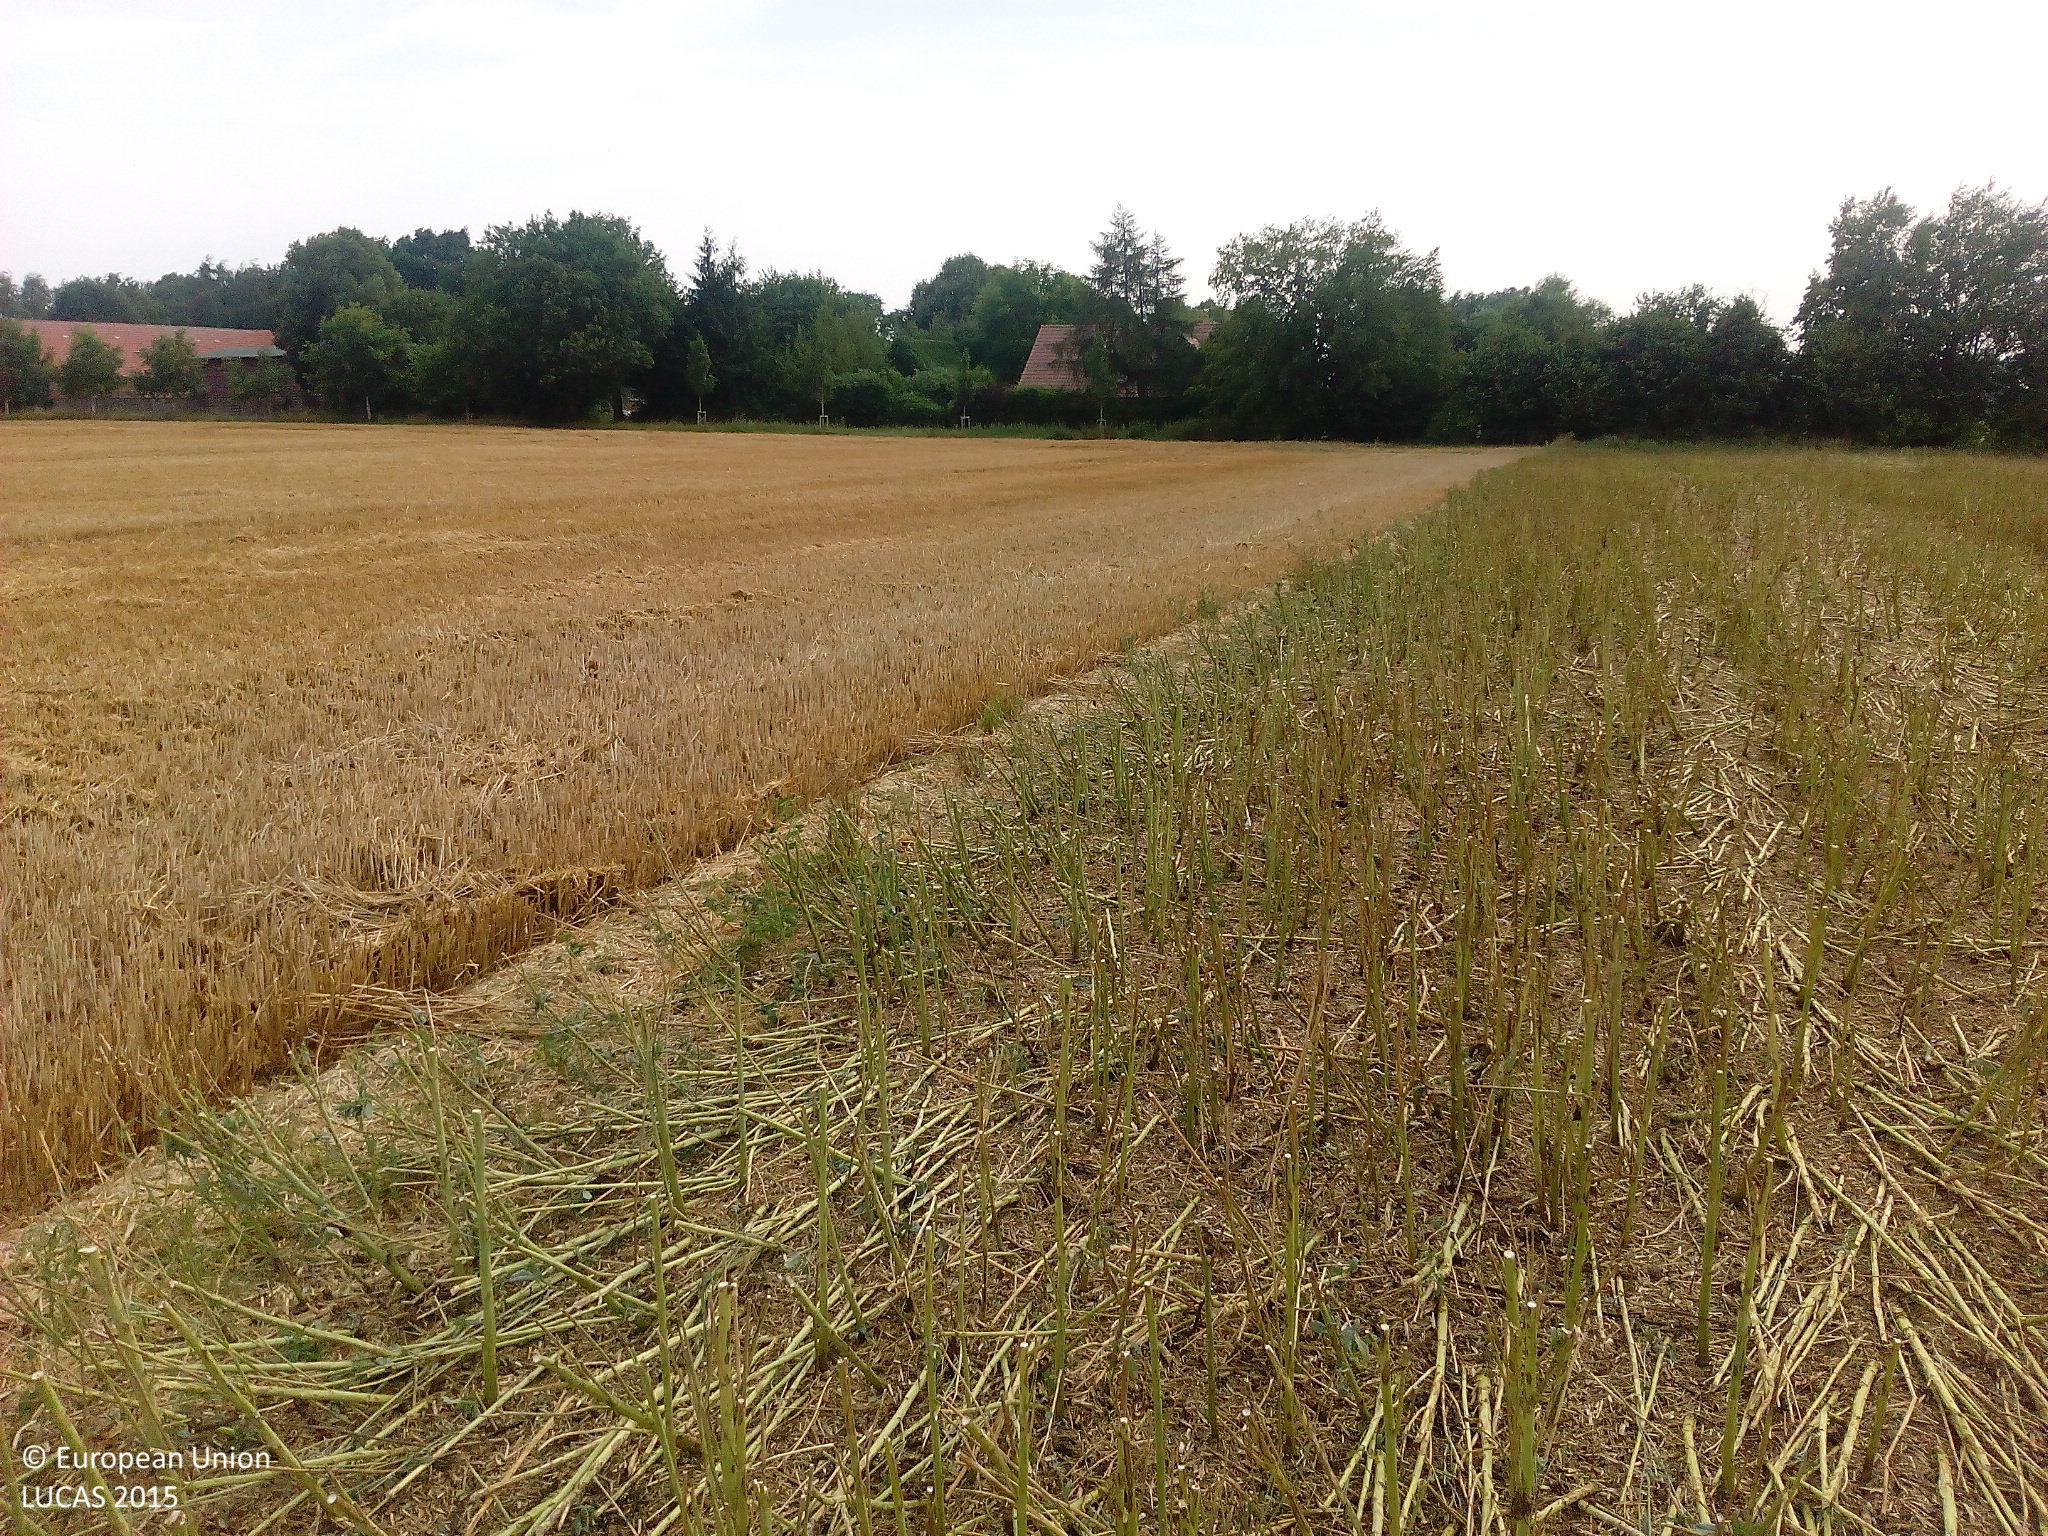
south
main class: Cropland
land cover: Rape and turnip rape
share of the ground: < 10 %
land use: Agriculture (excluding fallow land and kitchen gardens)
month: August
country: DE
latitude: 53.7909
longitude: 12.4431
